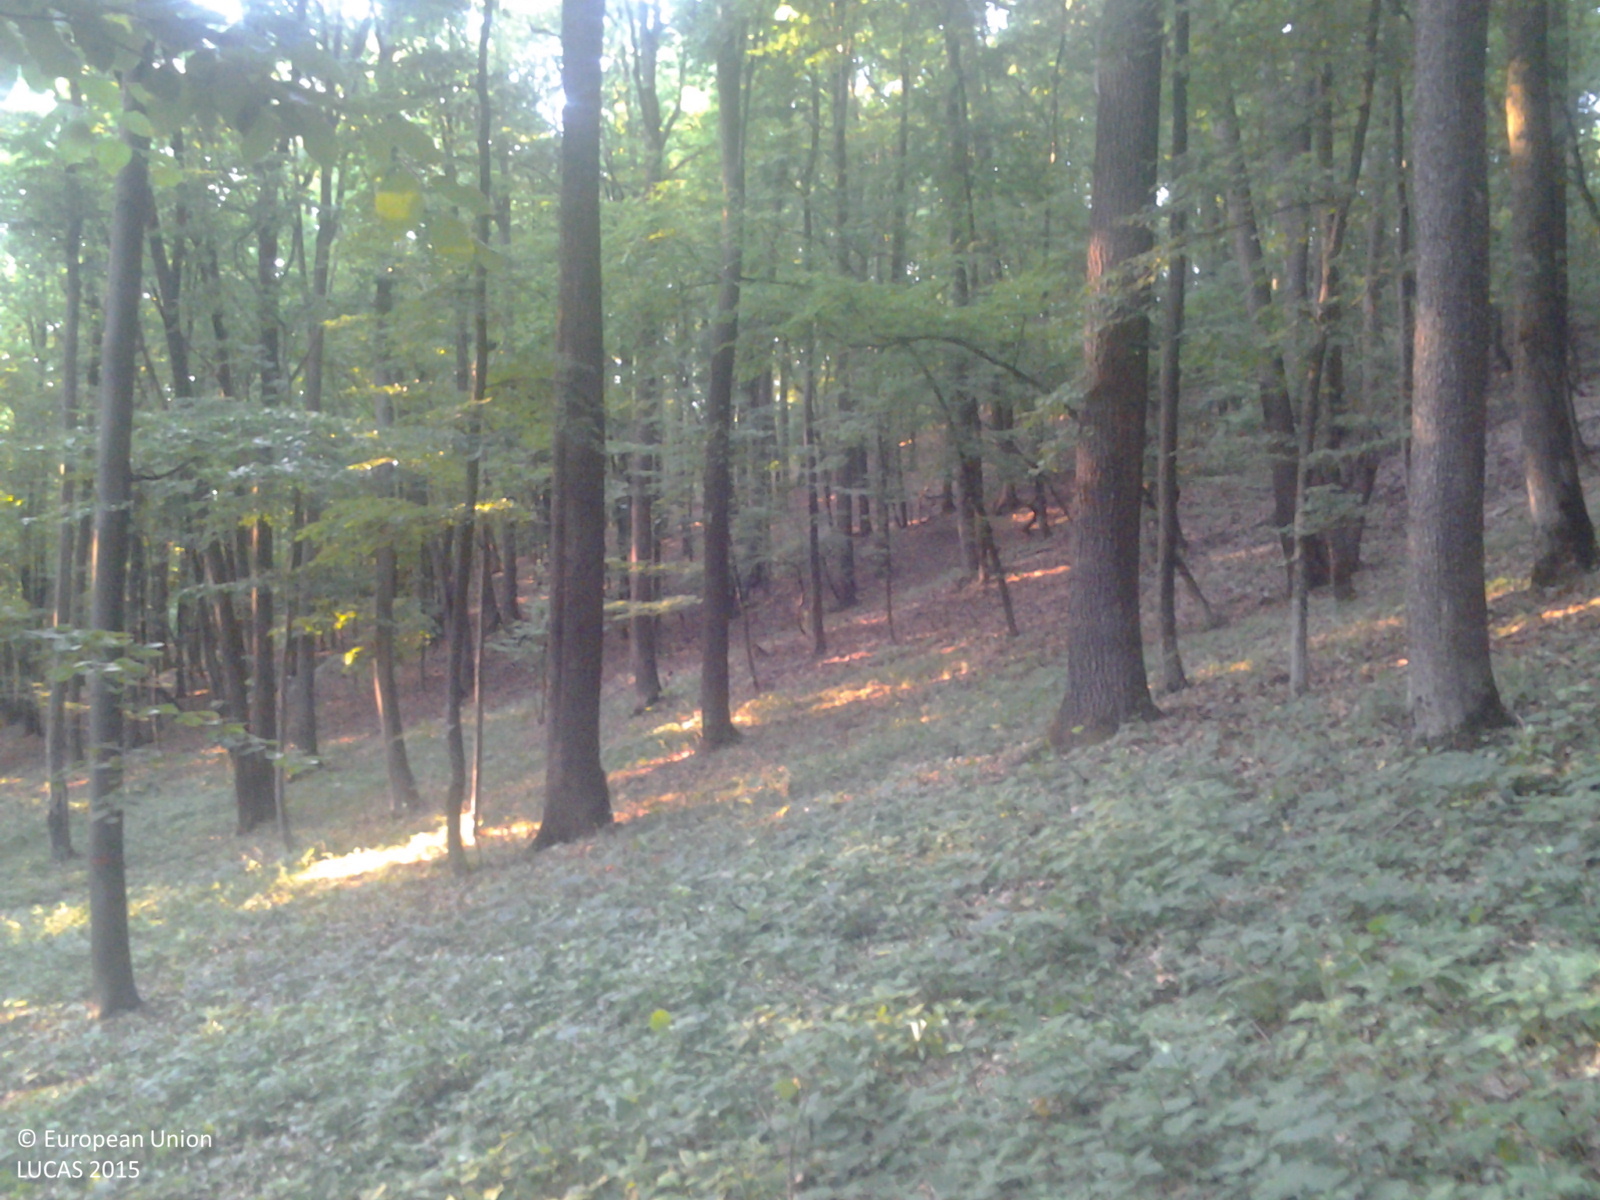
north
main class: Woodland
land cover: Broadleaved woodland
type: beech forest
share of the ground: > 75 %
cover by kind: broadleaved forest trees 100 %
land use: Forestry
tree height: > 5 m
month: June
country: RO
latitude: 46.3491
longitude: 27.1610
